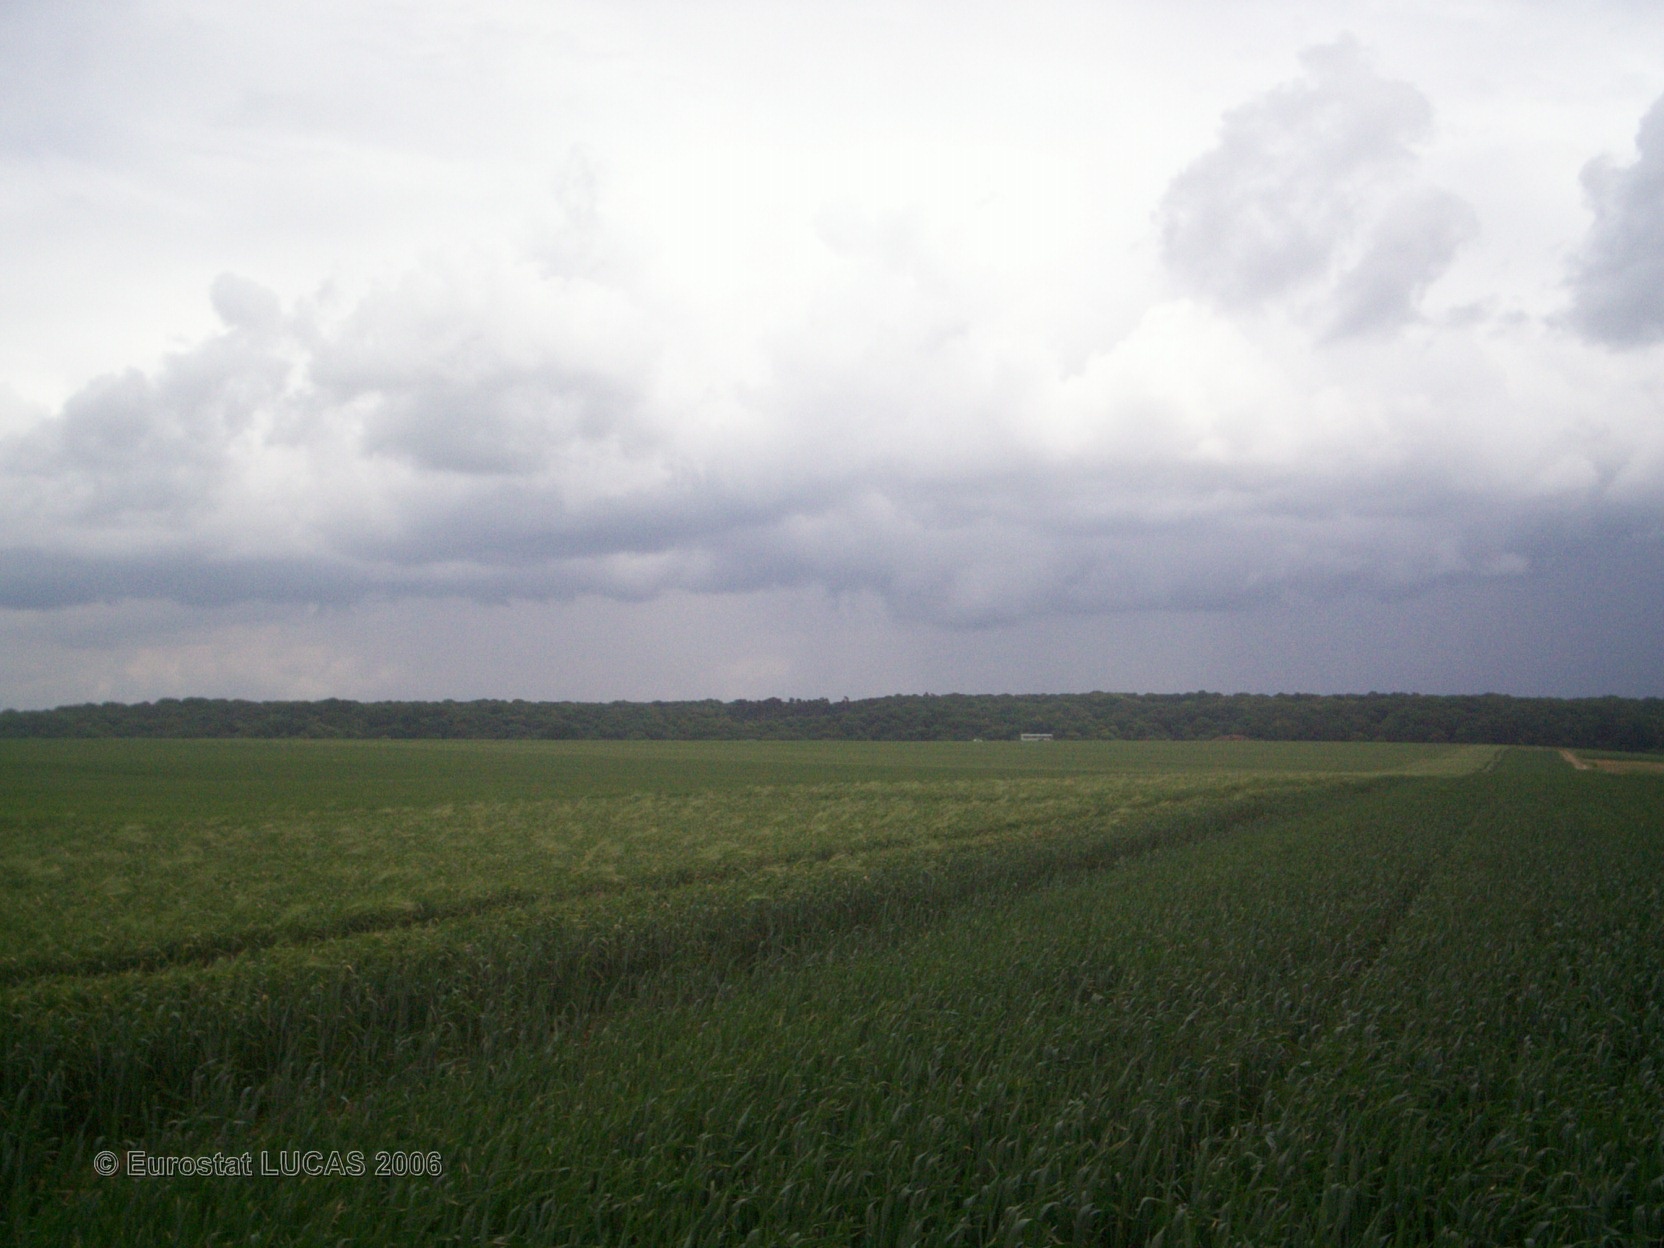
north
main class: Cropland
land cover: Common wheat
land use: Agriculture (excluding fallow land and kitchen gardens)
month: May
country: FR
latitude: 49.1203
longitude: 2.7138
